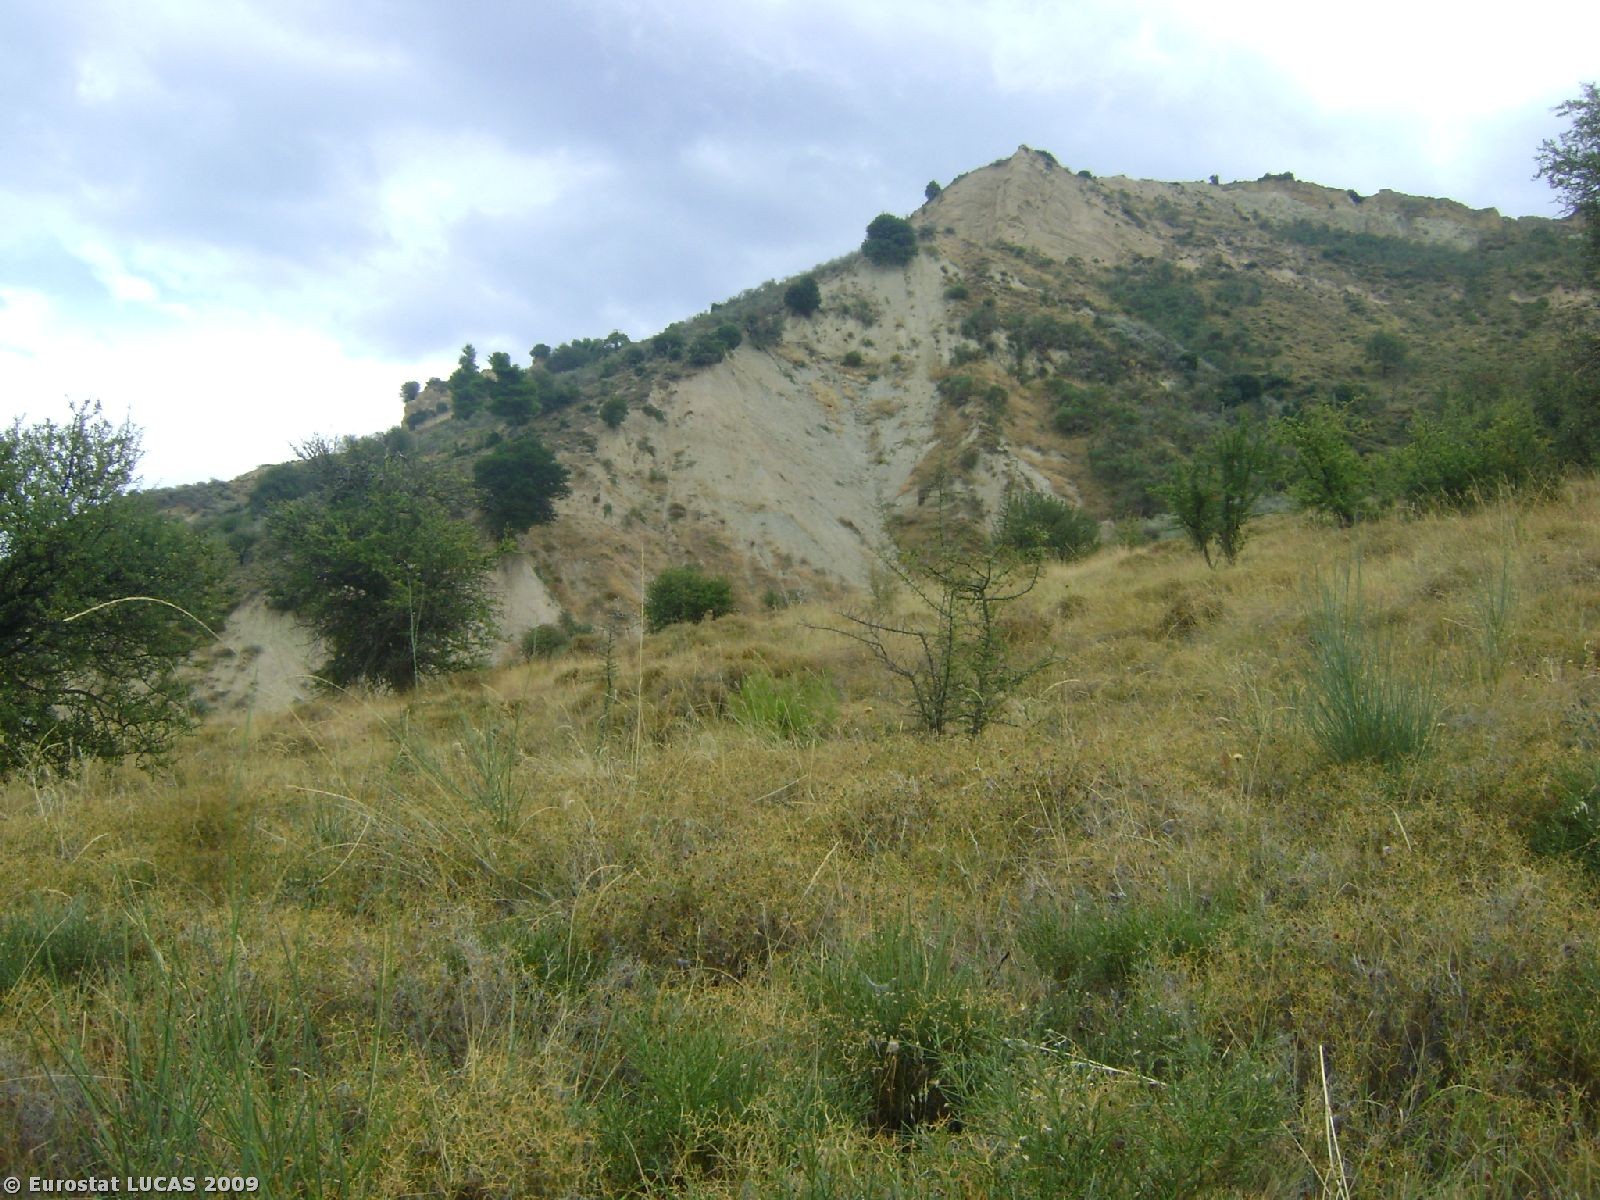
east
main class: Shrubland
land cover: Shrubland with sparse tree cover
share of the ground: > 75 %
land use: Unused
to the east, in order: Shrubland with sparse tree cover; Grassland without tree/shrub cover; Bare land; Rock outcrops; Shrubland with sparse tree cover
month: October
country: GR
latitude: 38.1181
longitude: 22.2998
